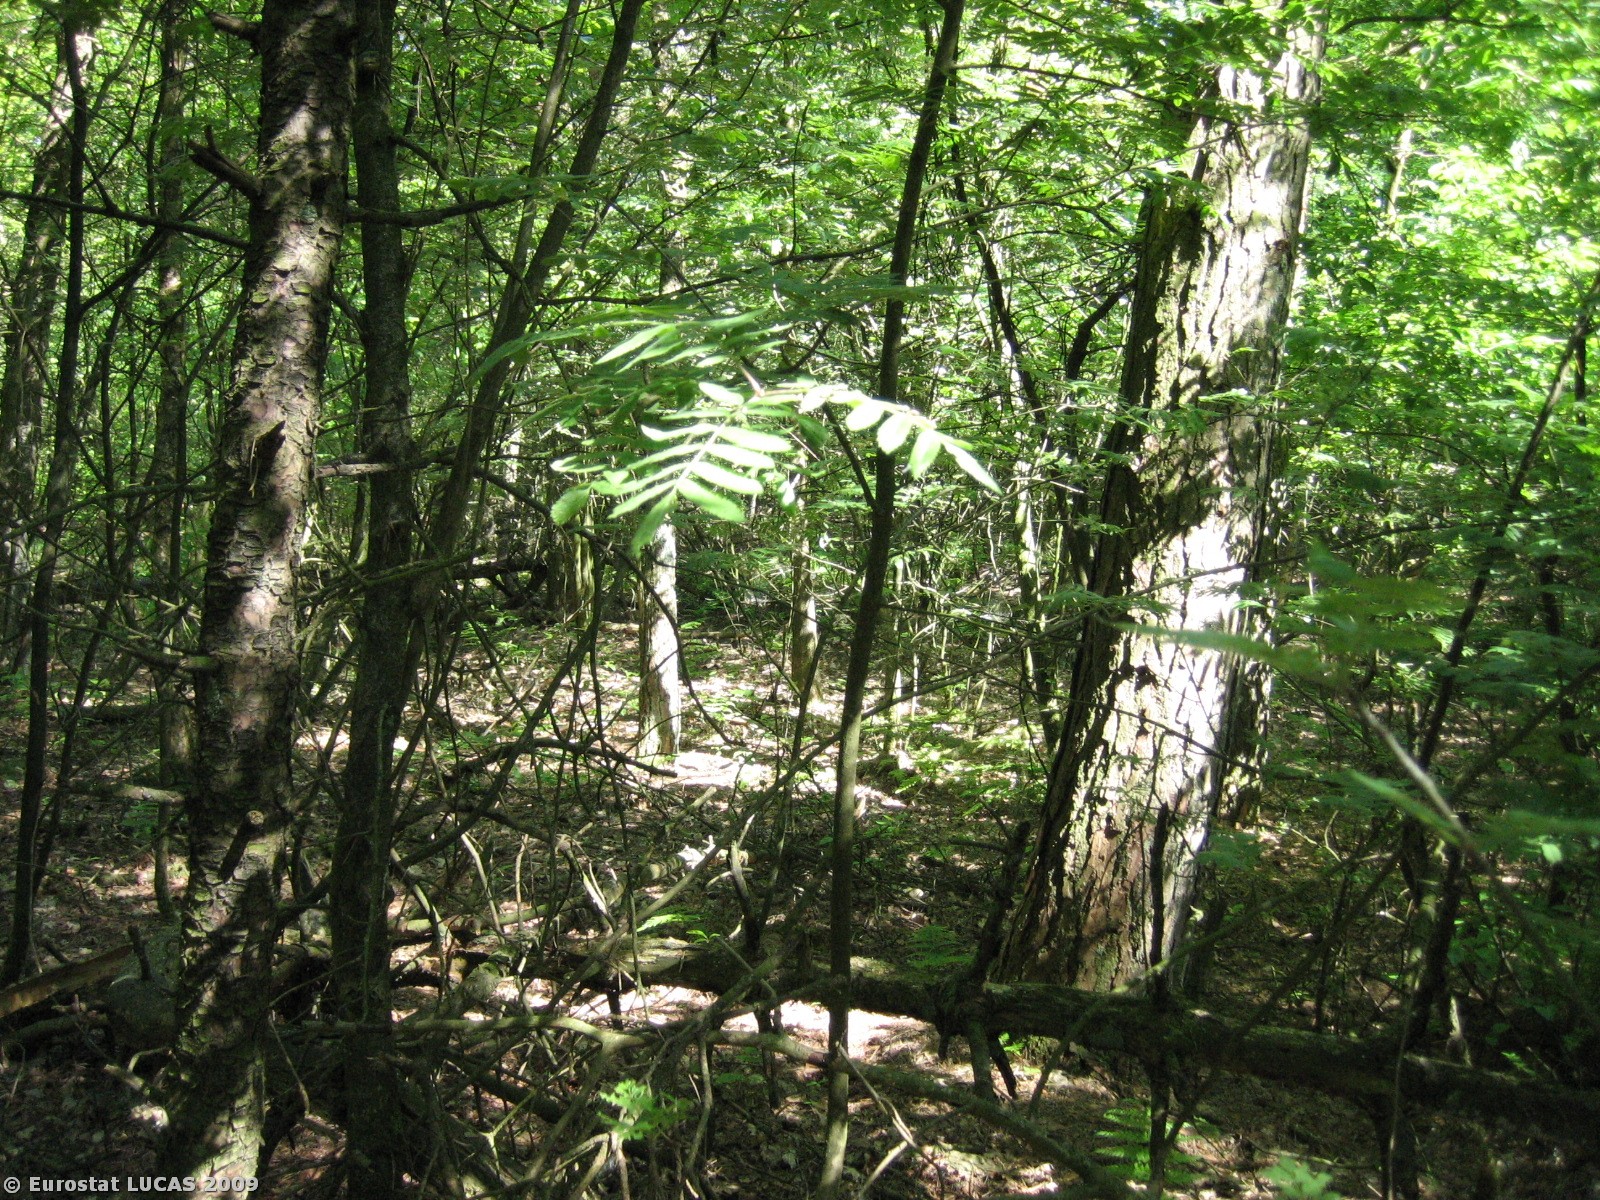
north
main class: Woodland
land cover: Mixed woodland
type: mesophytic deciduous forest
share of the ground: > 75 %
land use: Unused
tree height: > 5 m
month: May
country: DK
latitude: 55.9139
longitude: 8.9612
